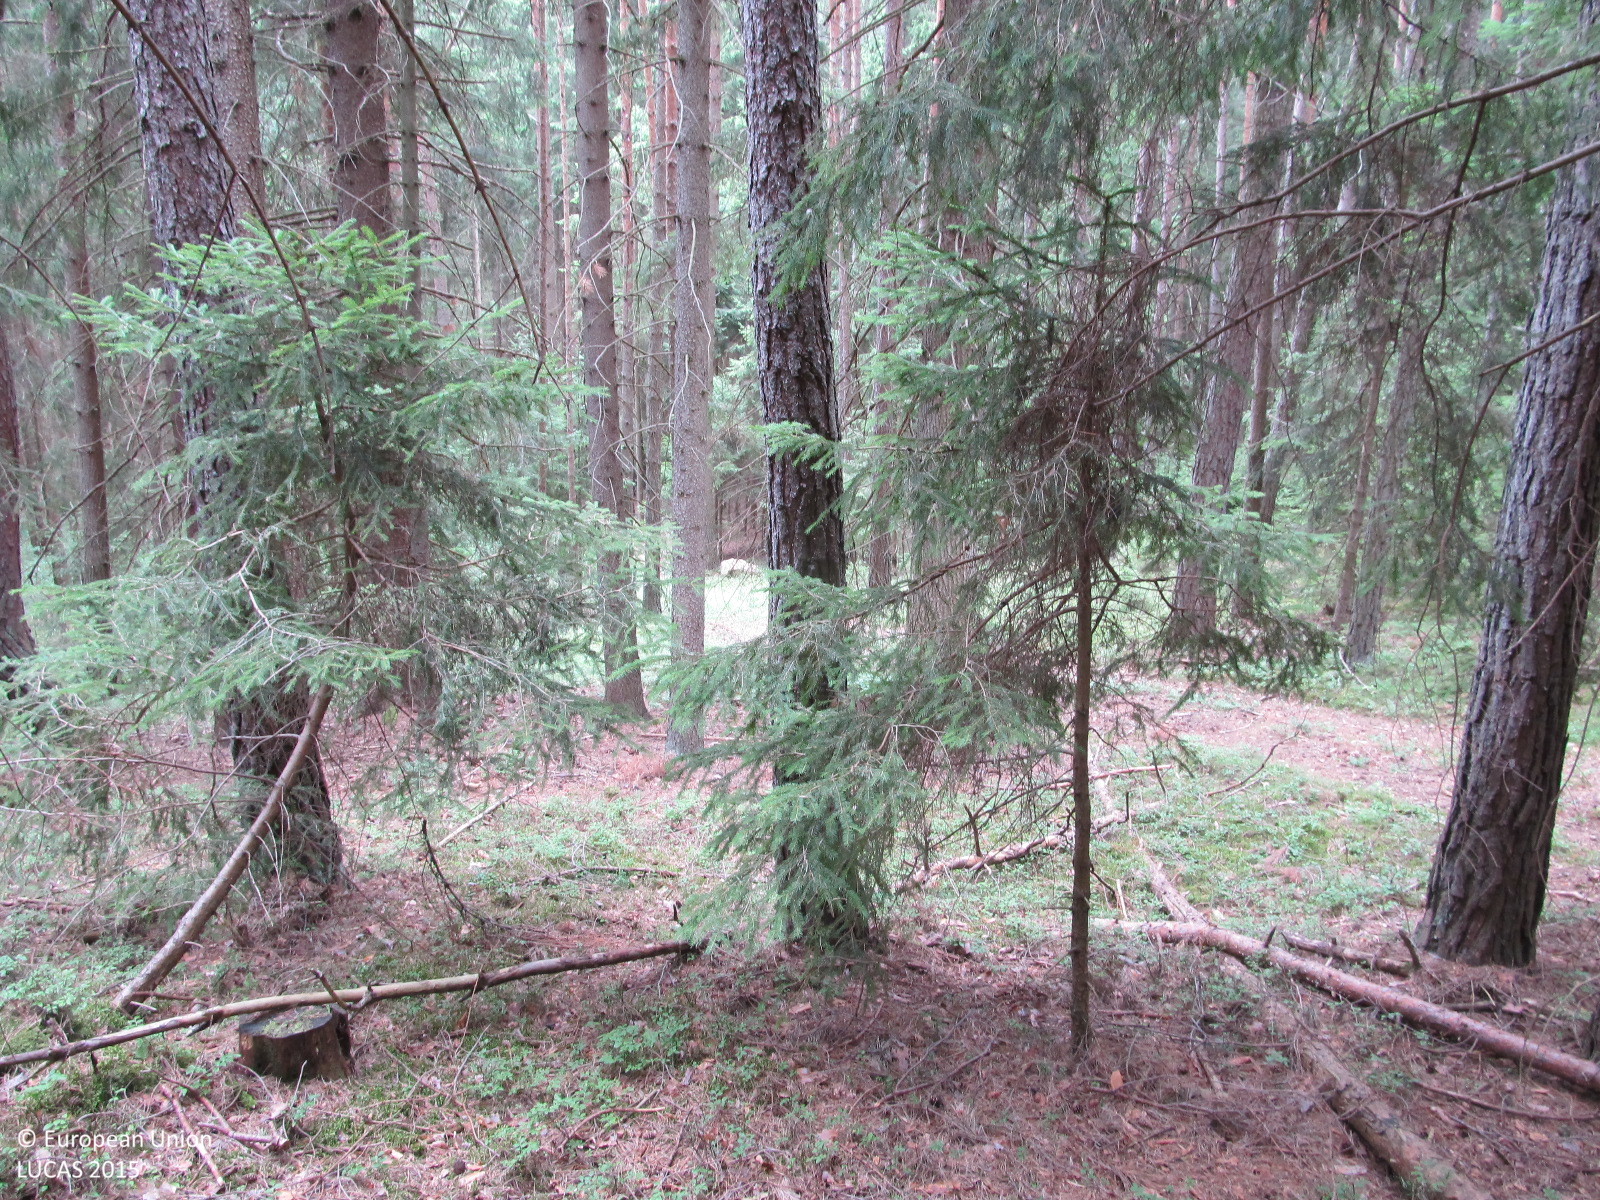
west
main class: Woodland
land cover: Other coniferous woodland
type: hemiboreal forest and nemoral coniferous forest and mixed broadleaved-coniferous forest
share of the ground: > 75 %
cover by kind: coniferous forest trees 80 %, lichens and mosses 10 %, herbaceous plants 5 %, unconsolidated bare surface 5 %
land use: Forestry
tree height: > 5 m
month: July
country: AT
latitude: 48.5930
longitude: 15.0863
